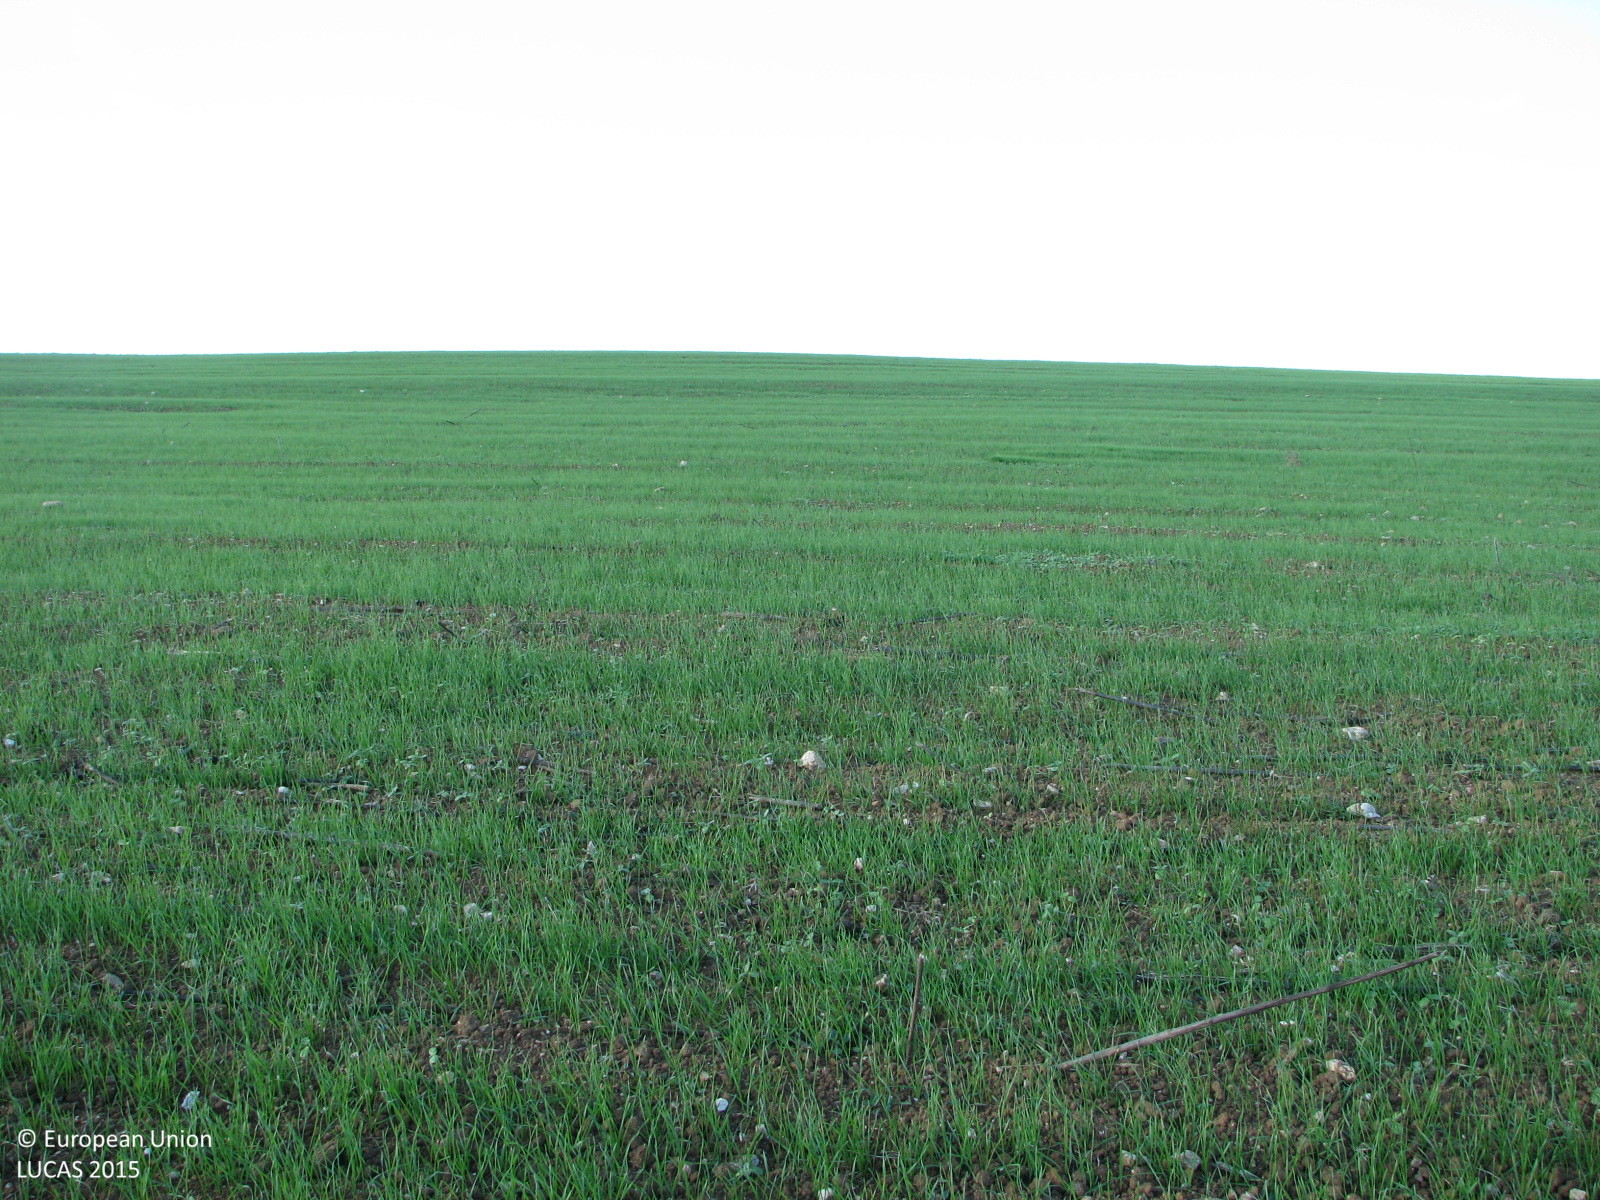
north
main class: Cropland
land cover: Common wheat
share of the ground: 50 - 75 %
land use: Agriculture (excluding fallow land and kitchen gardens)
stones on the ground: < 10 %
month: October
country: BG
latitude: 42.1020
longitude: 26.3722
